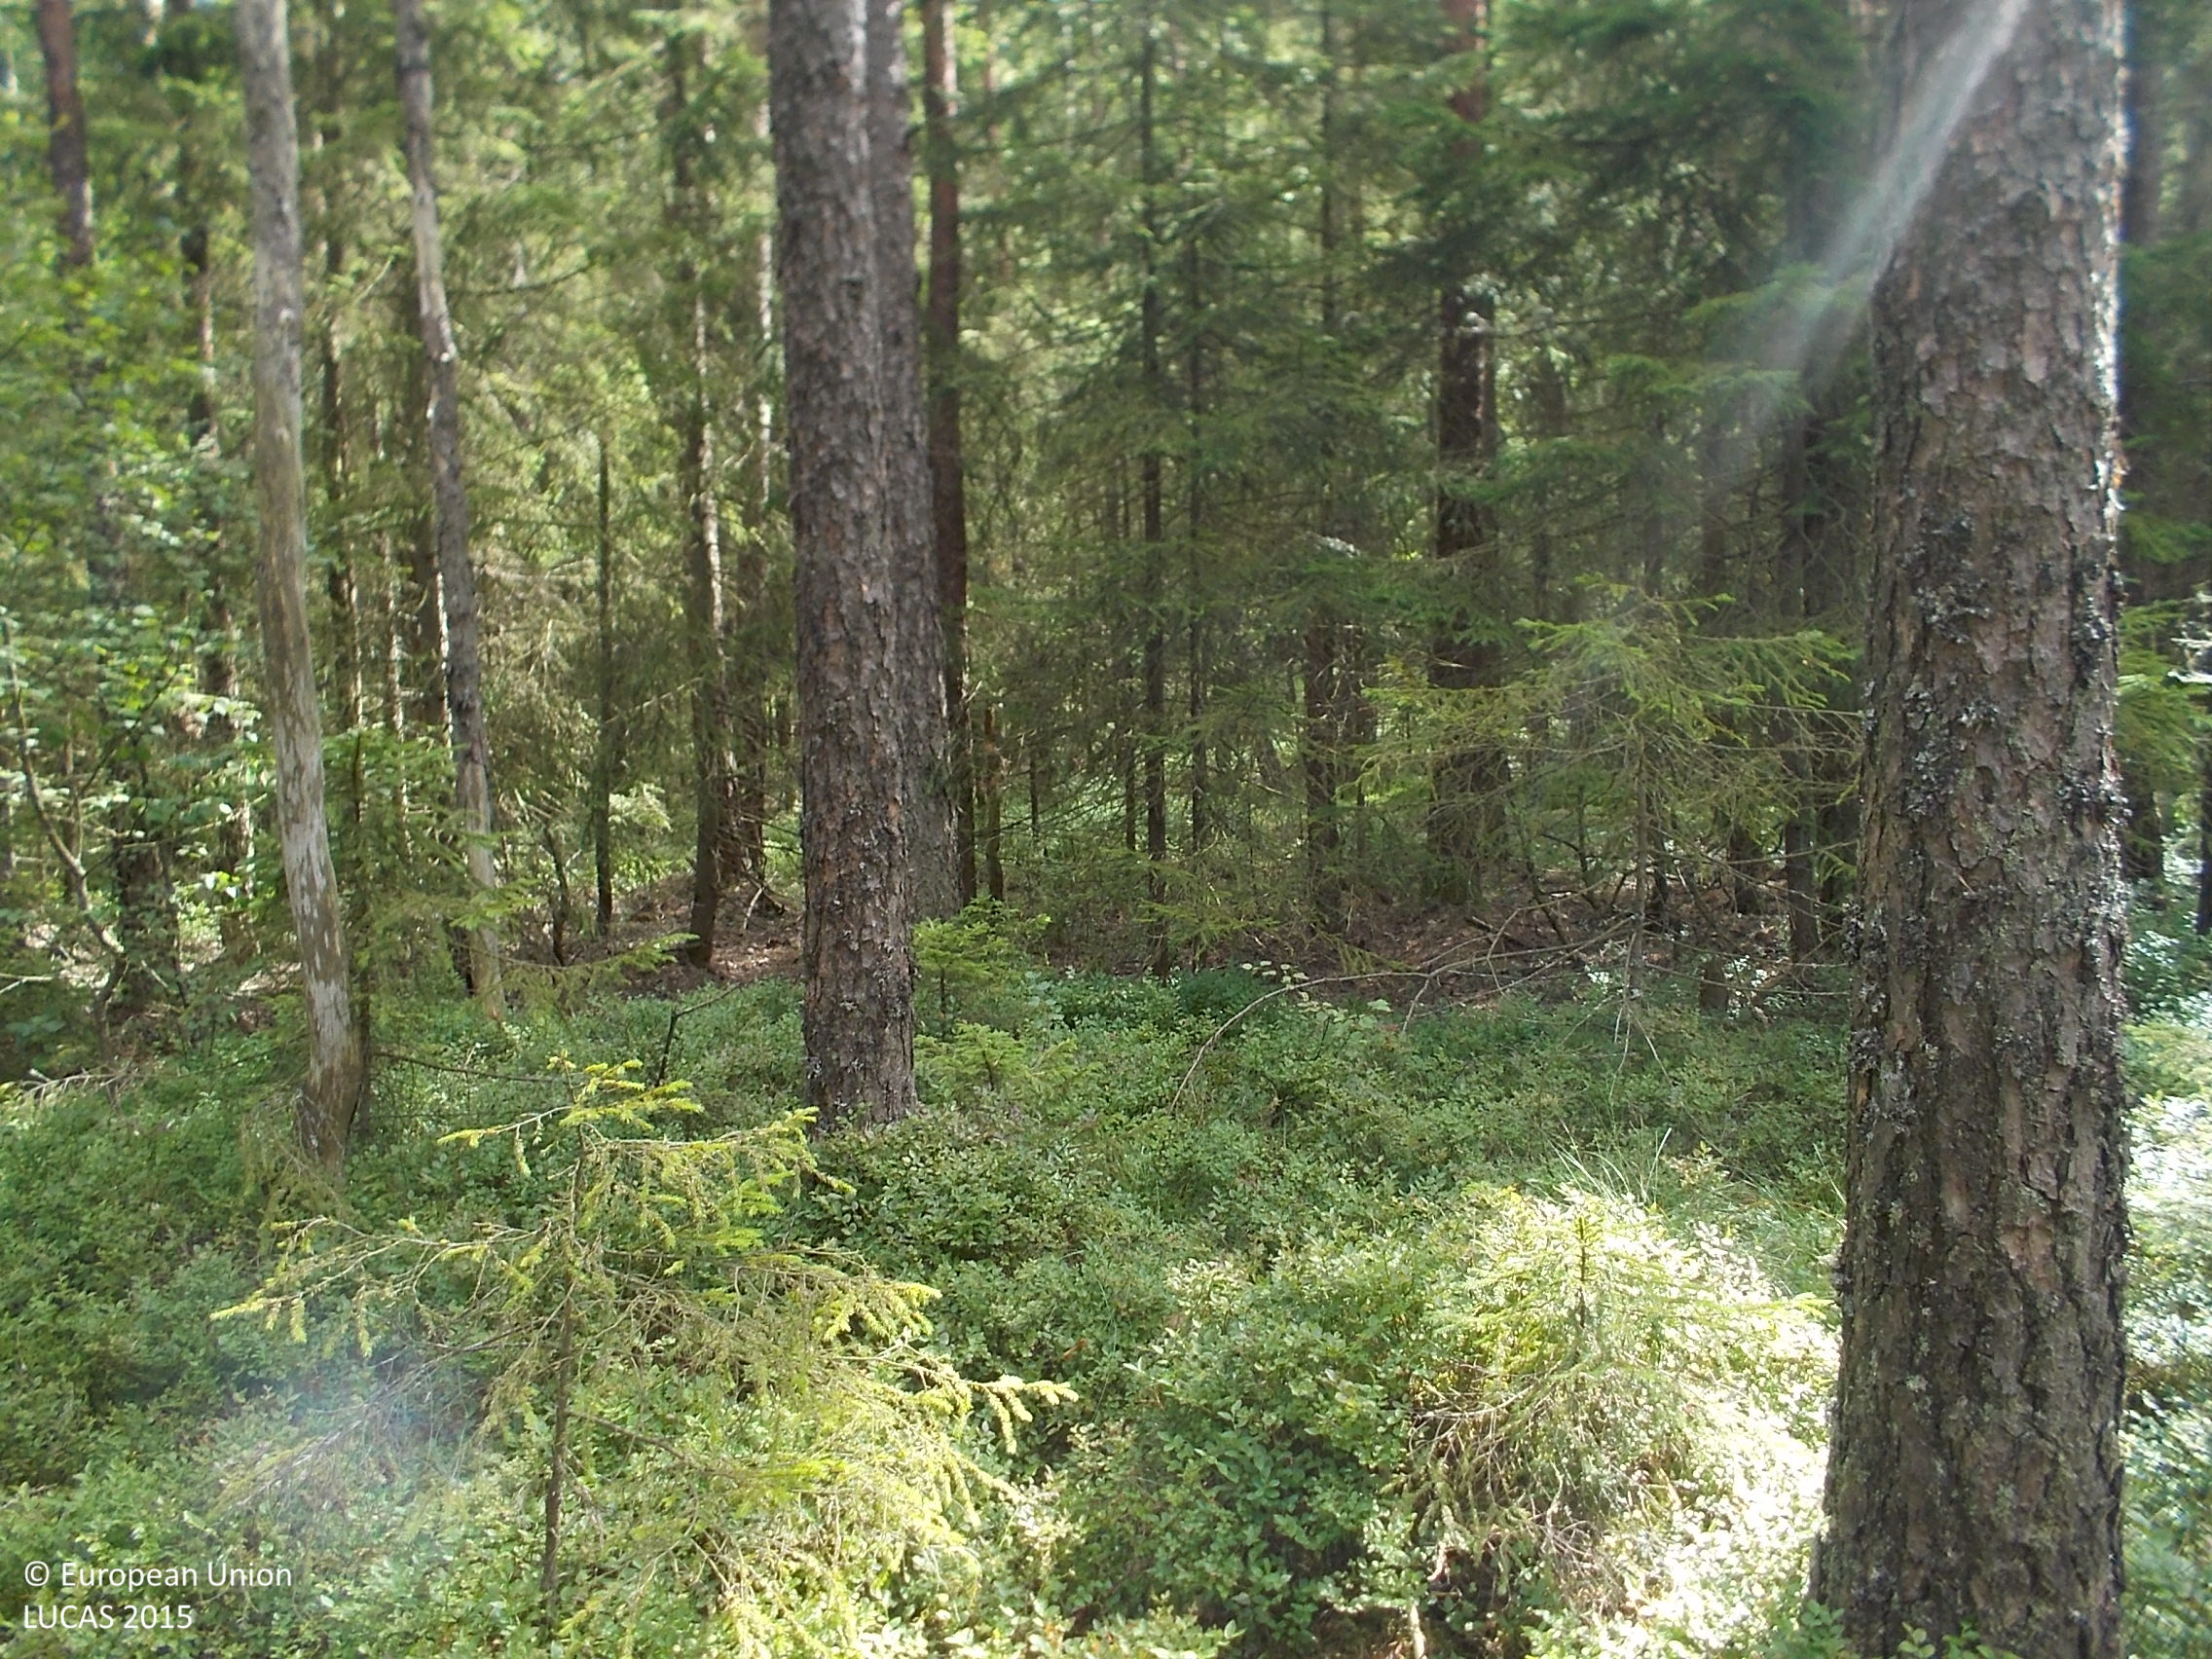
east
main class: Woodland
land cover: Pine dominated coniferous woodland
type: boreal forest
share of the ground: > 75 %
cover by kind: coniferous forest trees 85 %, shrubs 10 %, herbaceous plants 5 %
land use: Forestry
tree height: > 5 m
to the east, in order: Pine dominated coniferous woodland; Shruby margins; Tracks; Shruby margins; Spruce dominated coniferous woodland; Spruce dominated mixed woodland; Spruce dominated coniferous woodland
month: August
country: SE
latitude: 57.5883
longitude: 12.2881
